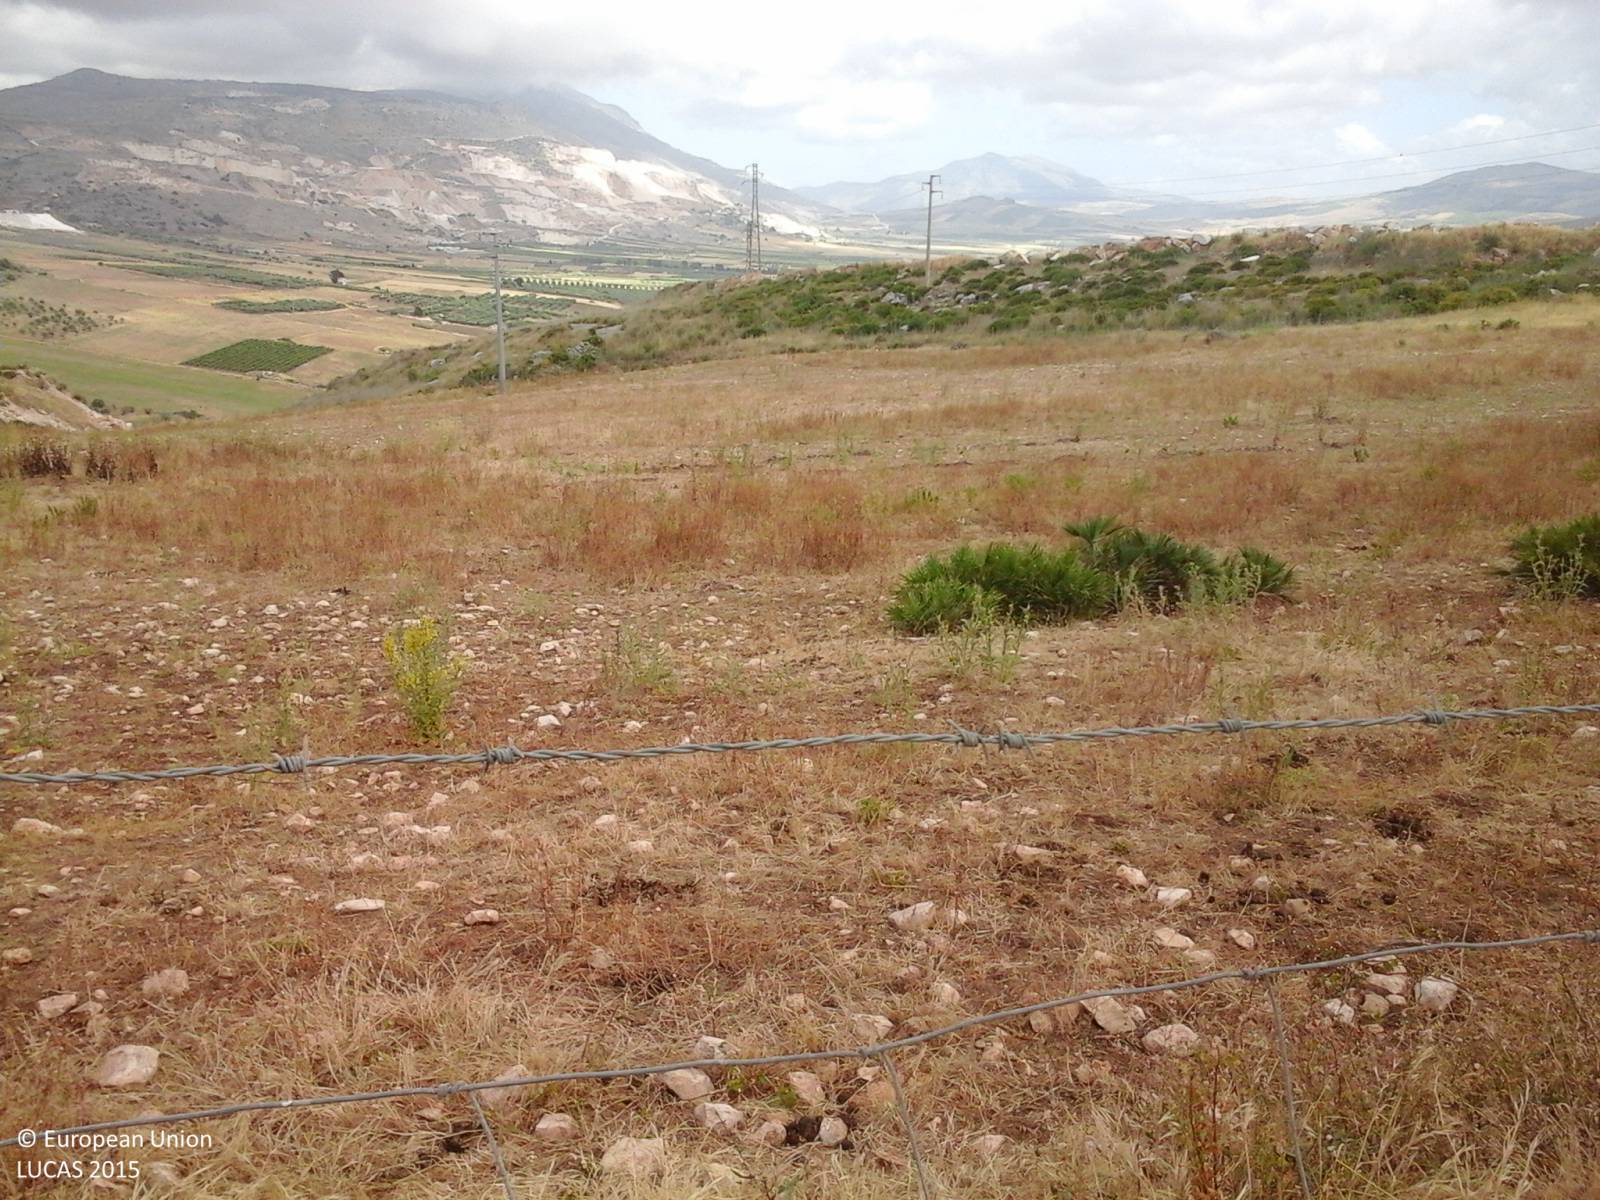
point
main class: Grassland
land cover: Spontaneously vegetated surfaces
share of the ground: > 75 %
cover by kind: herbaceous plants 100 %
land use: Fallow land
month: June
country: IT
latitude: 38.0554
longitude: 12.6591
